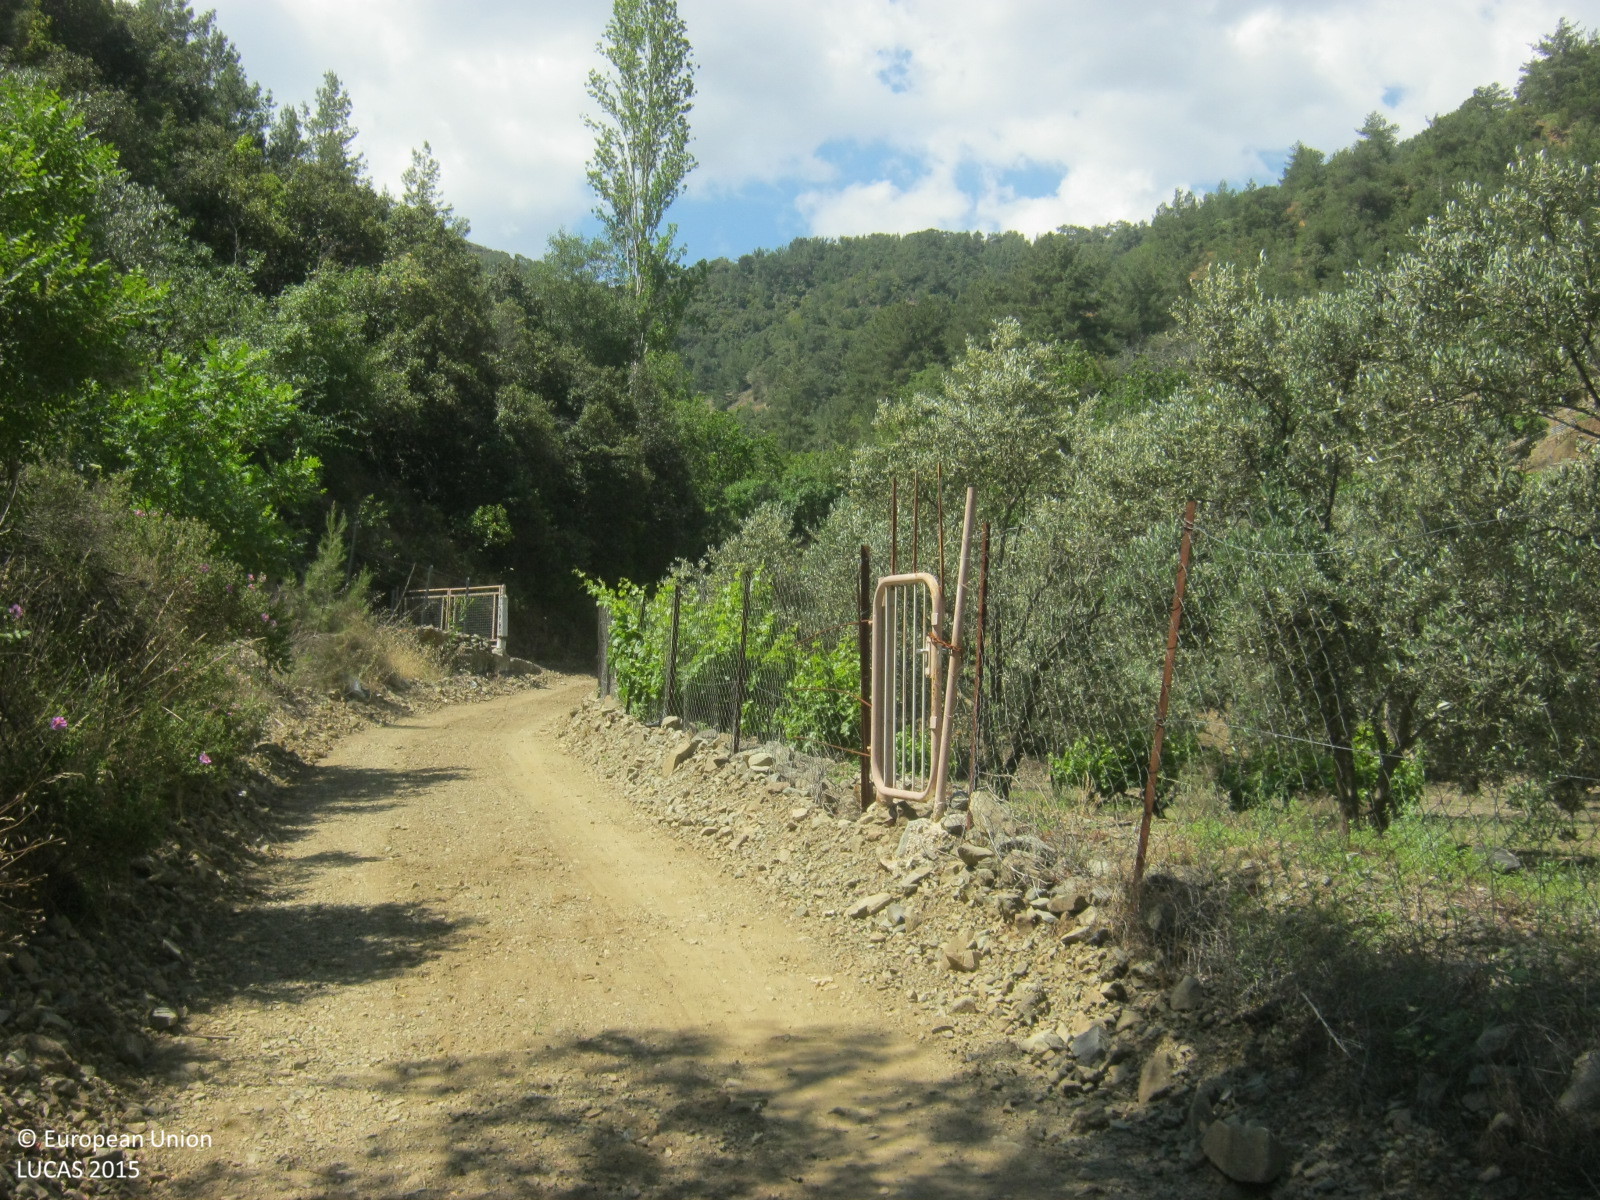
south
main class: Cropland
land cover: Olive groves
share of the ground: 50 - 75 %
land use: Agriculture (excluding fallow land and kitchen gardens)
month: June
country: CY
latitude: 34.9919
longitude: 32.8117
